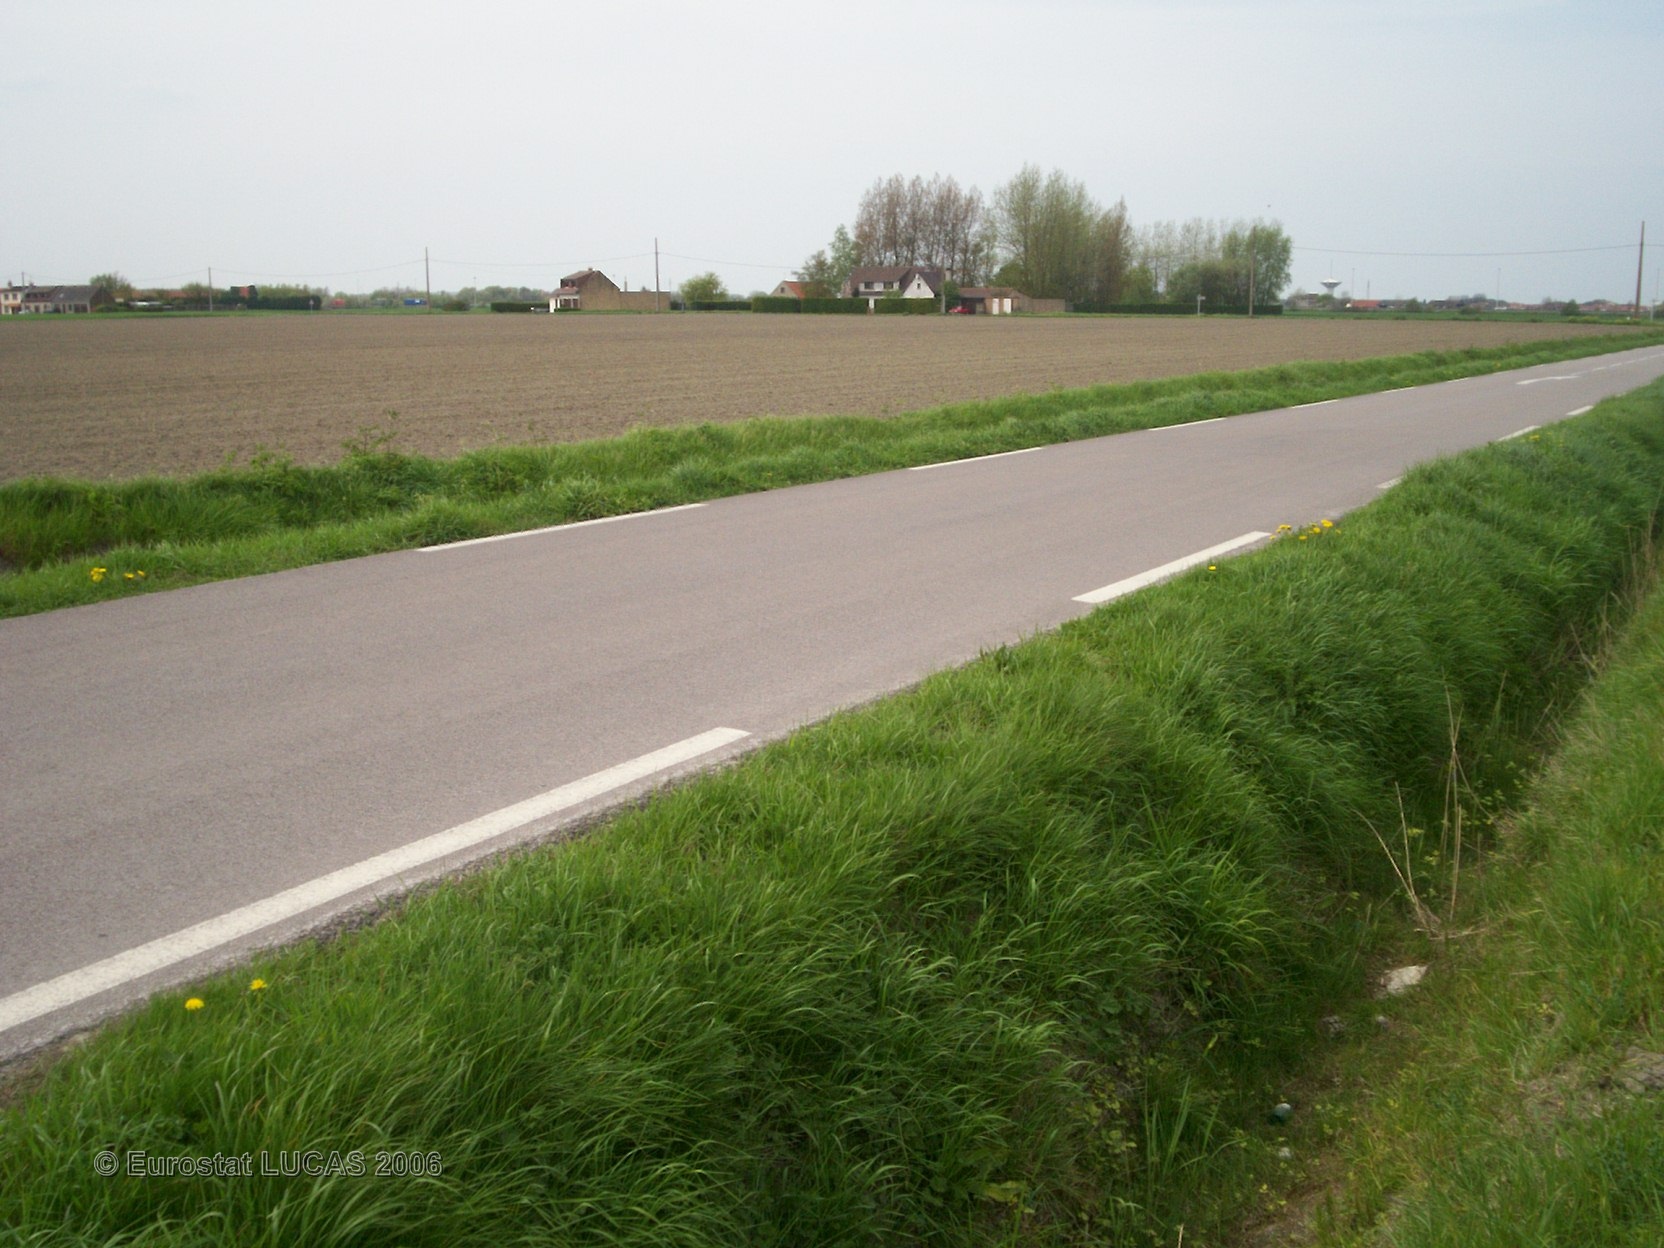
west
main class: Cropland
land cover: Common wheat
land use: Agriculture (excluding fallow land and kitchen gardens)
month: May
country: FR
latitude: 51.0368
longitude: 2.4715
